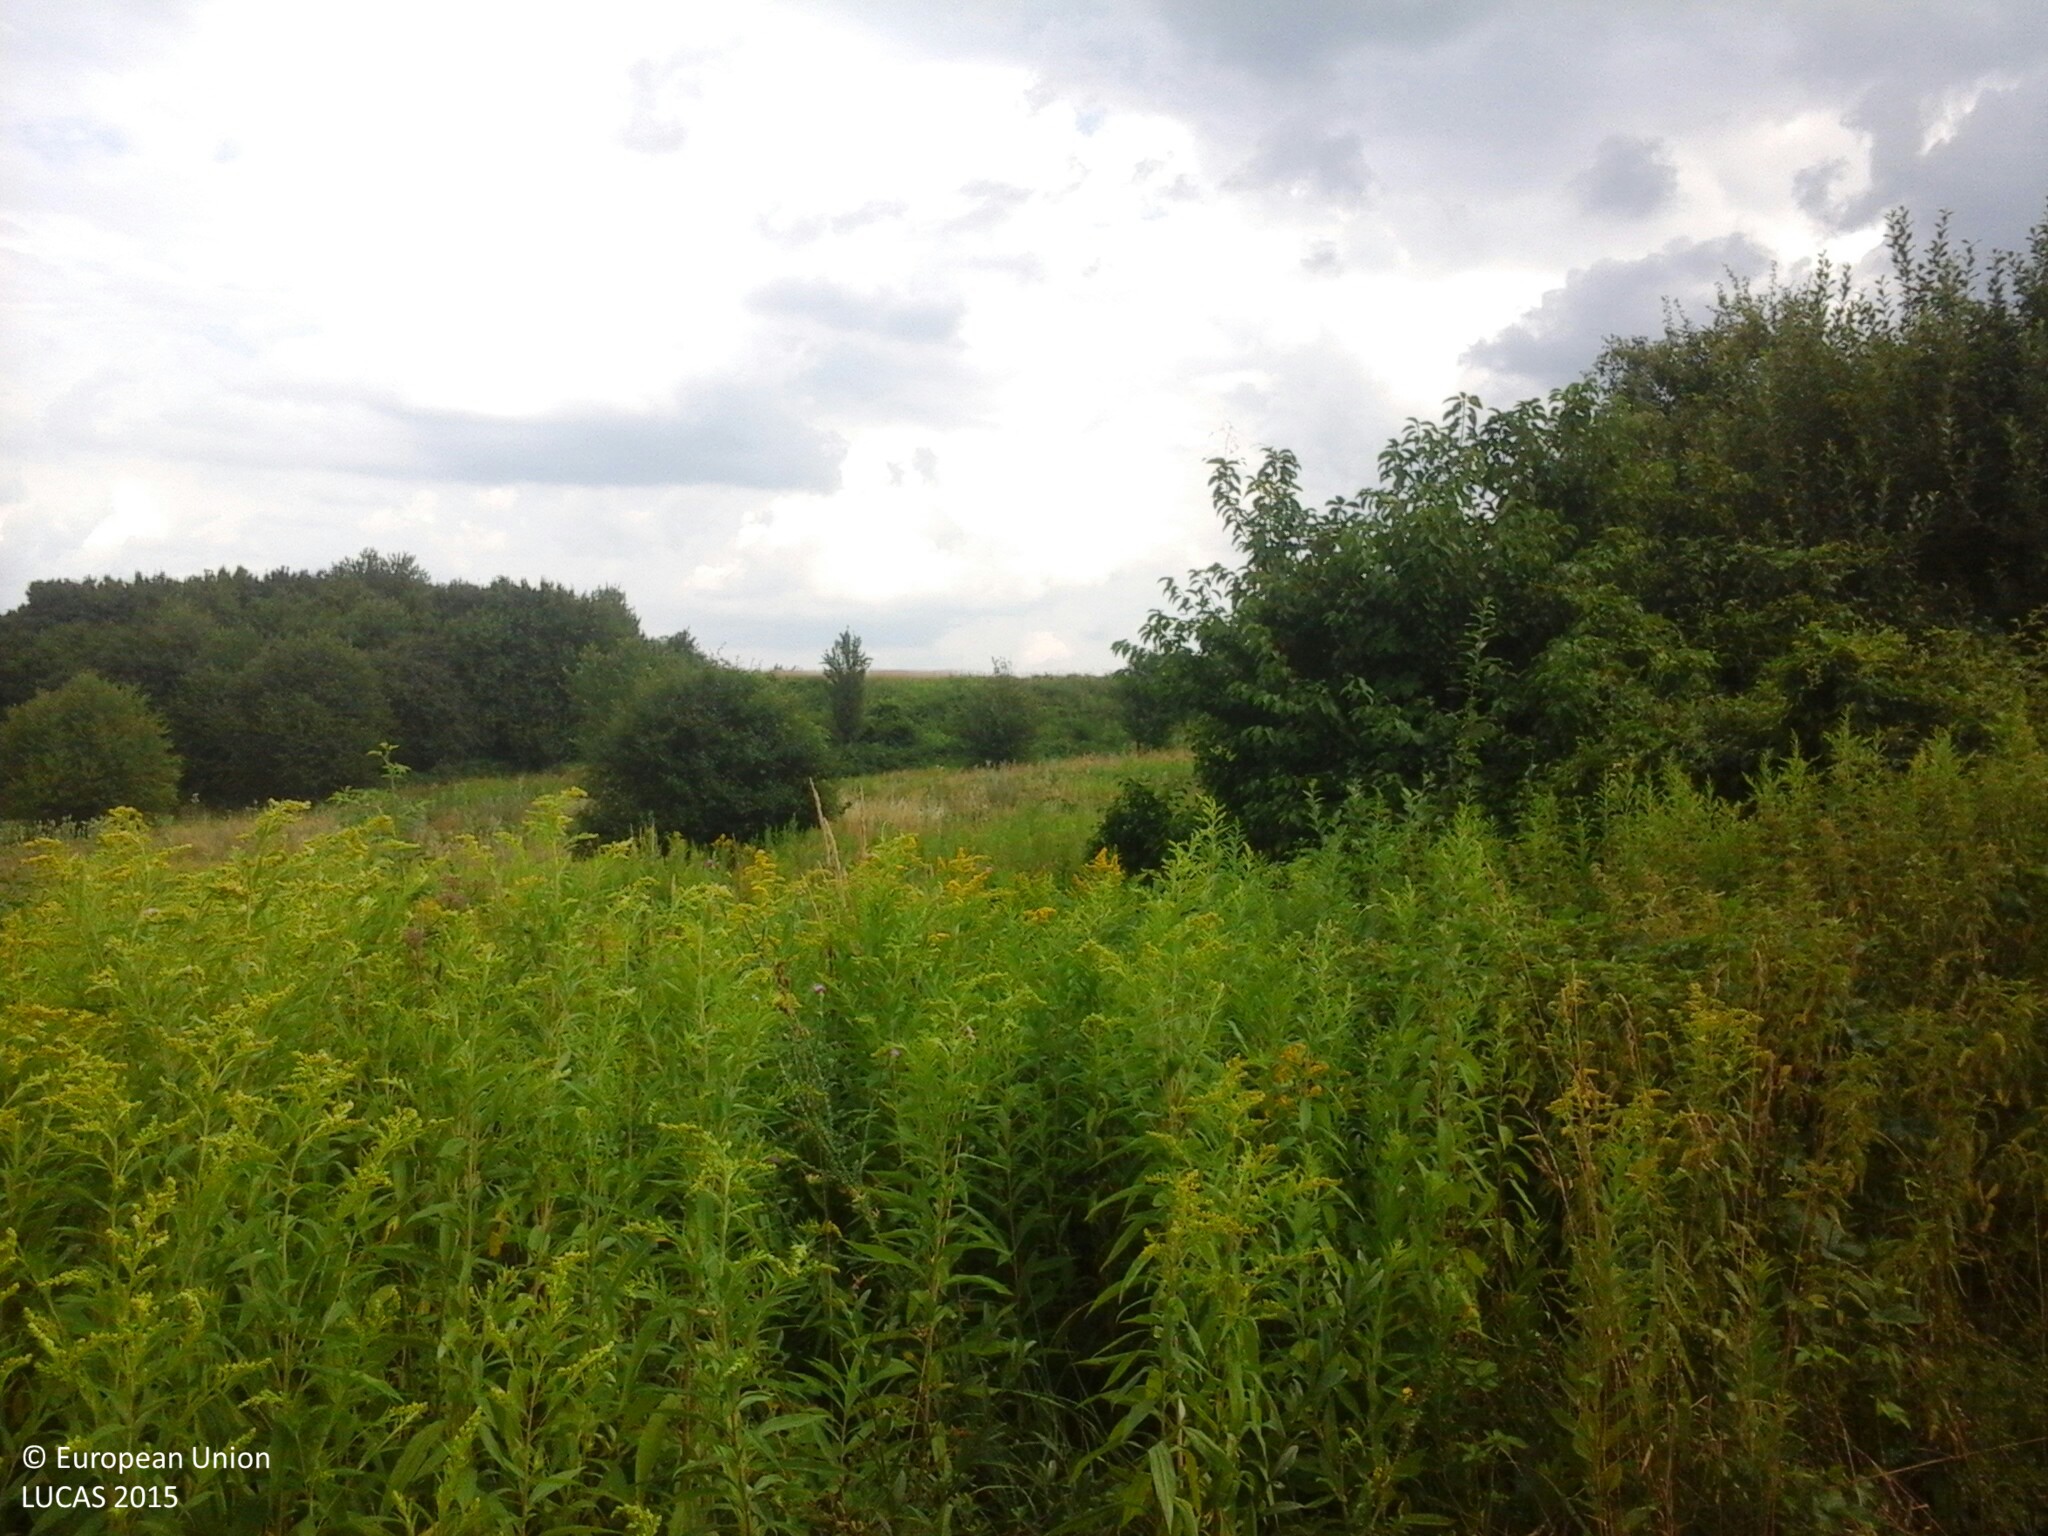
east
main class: Grassland
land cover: Spontaneously vegetated surfaces
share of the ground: > 75 %
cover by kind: herbaceous plants 100 %
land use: Semi-natural and natural areas not in use
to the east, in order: Spontaneously vegetated surfaces; Electric lines; Spontaneously vegetated surfaces; Electric lines; Spontaneously vegetated surfaces; Tracks; Shrubland with sparse tree cover
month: July
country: HU
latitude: 47.3007
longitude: 17.9849
